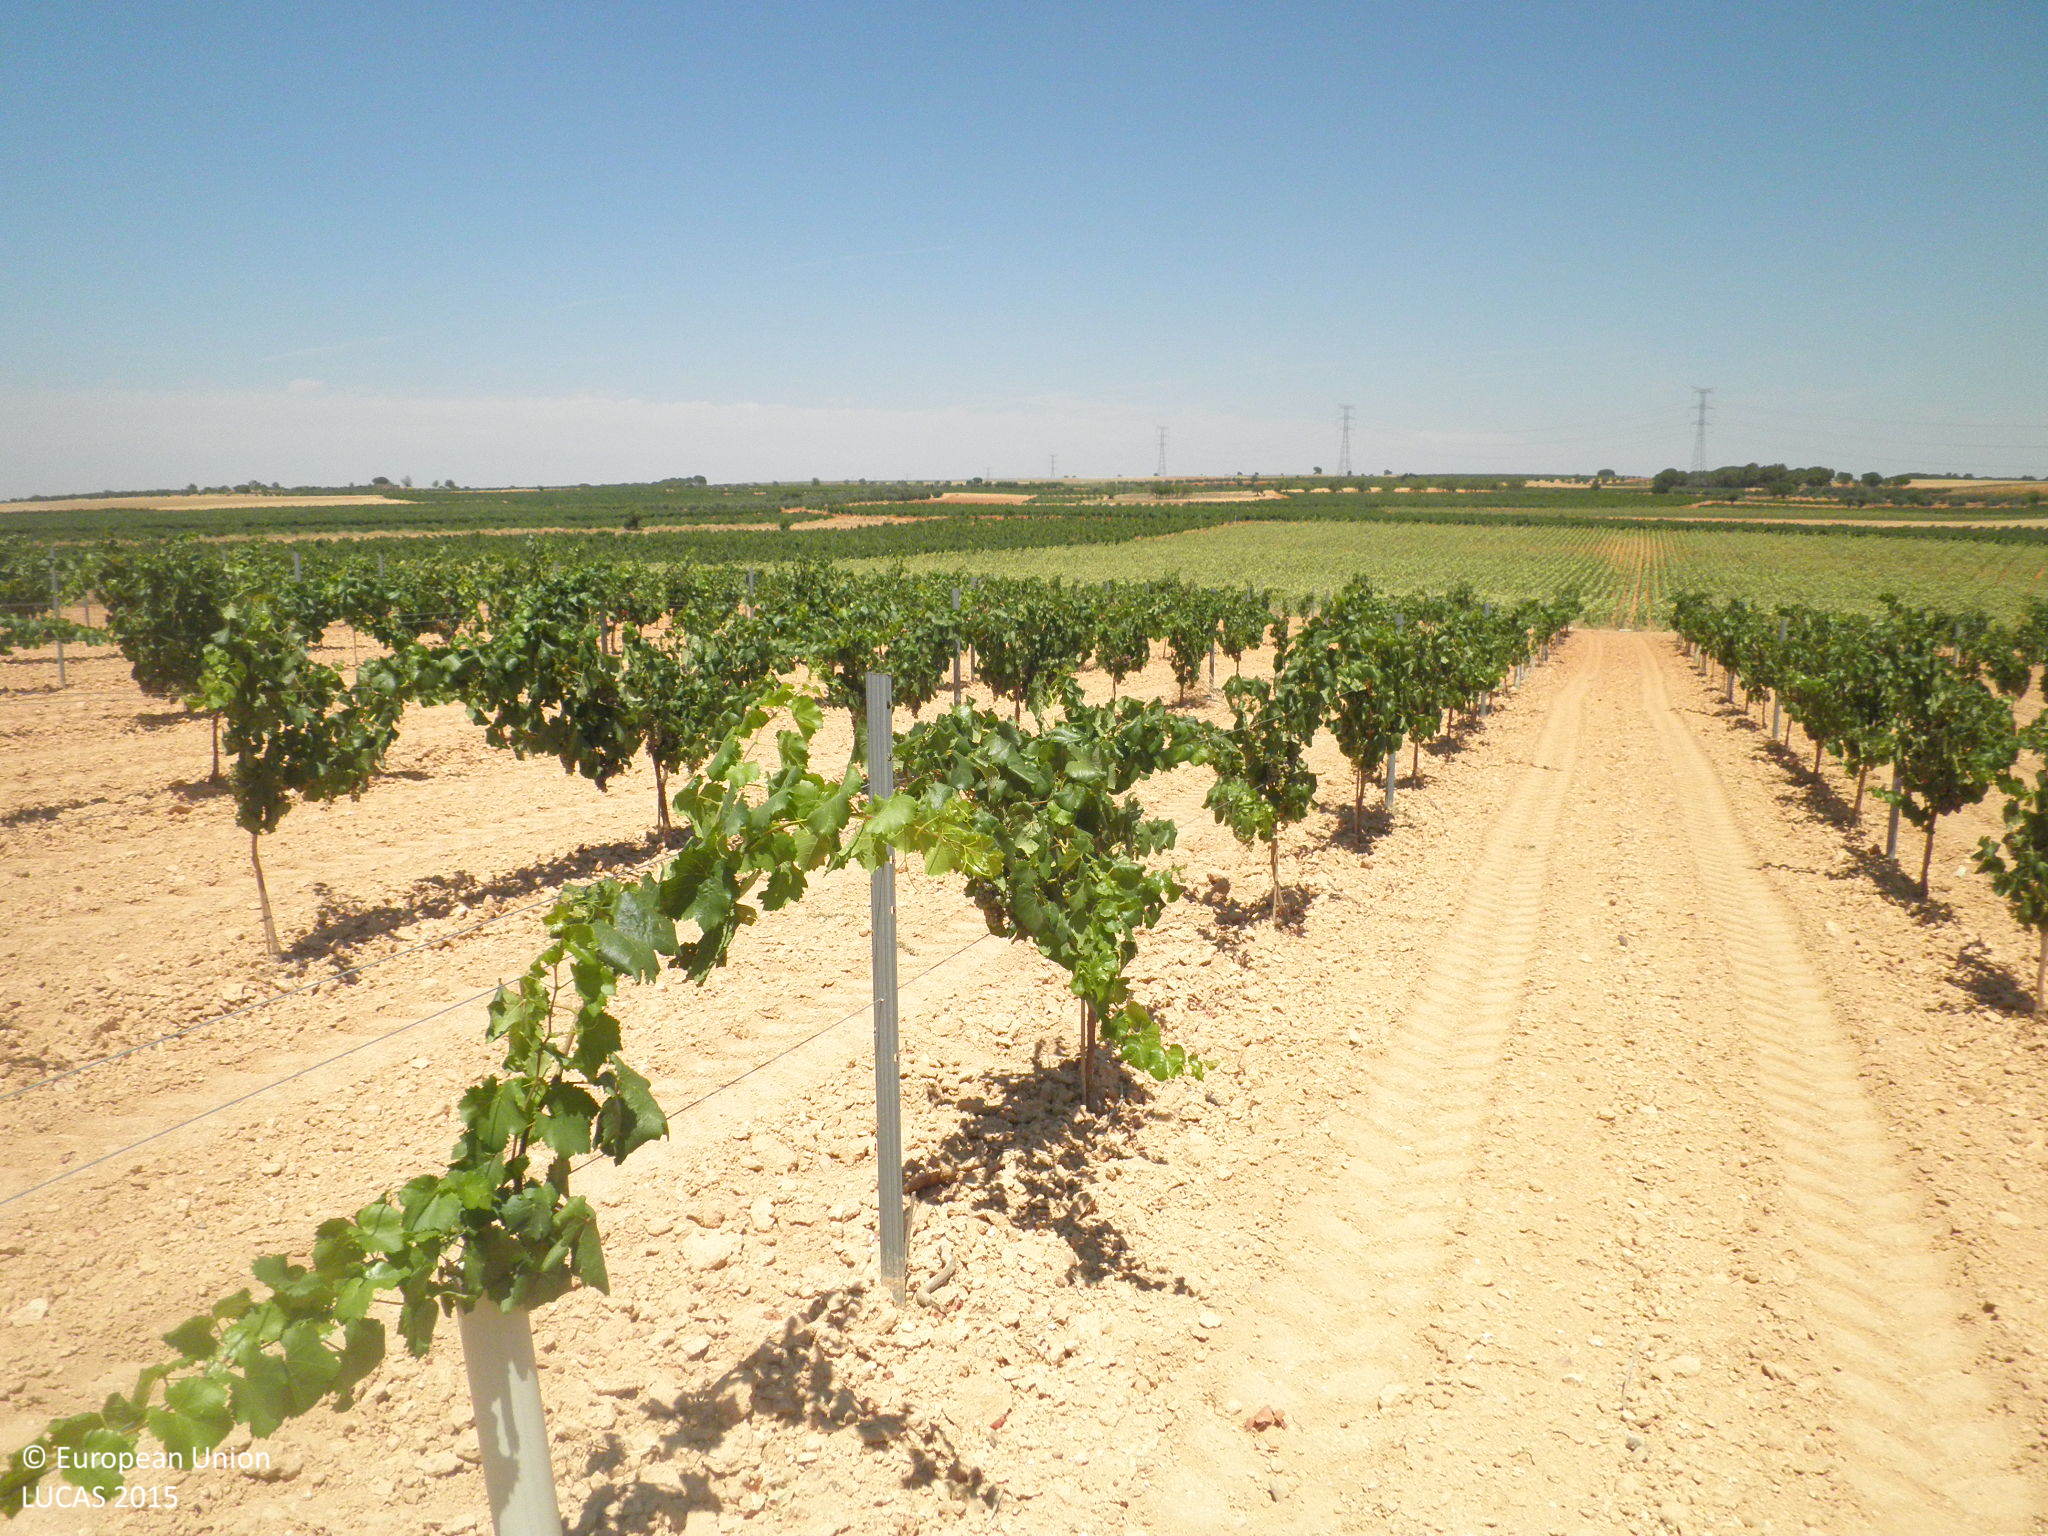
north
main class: Cropland
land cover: Vineyards
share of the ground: < 10 %
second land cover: Other bare soil
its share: > 75 %
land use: Agriculture (excluding fallow land and kitchen gardens)
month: July
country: ES
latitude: 39.3302
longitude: -1.8255
